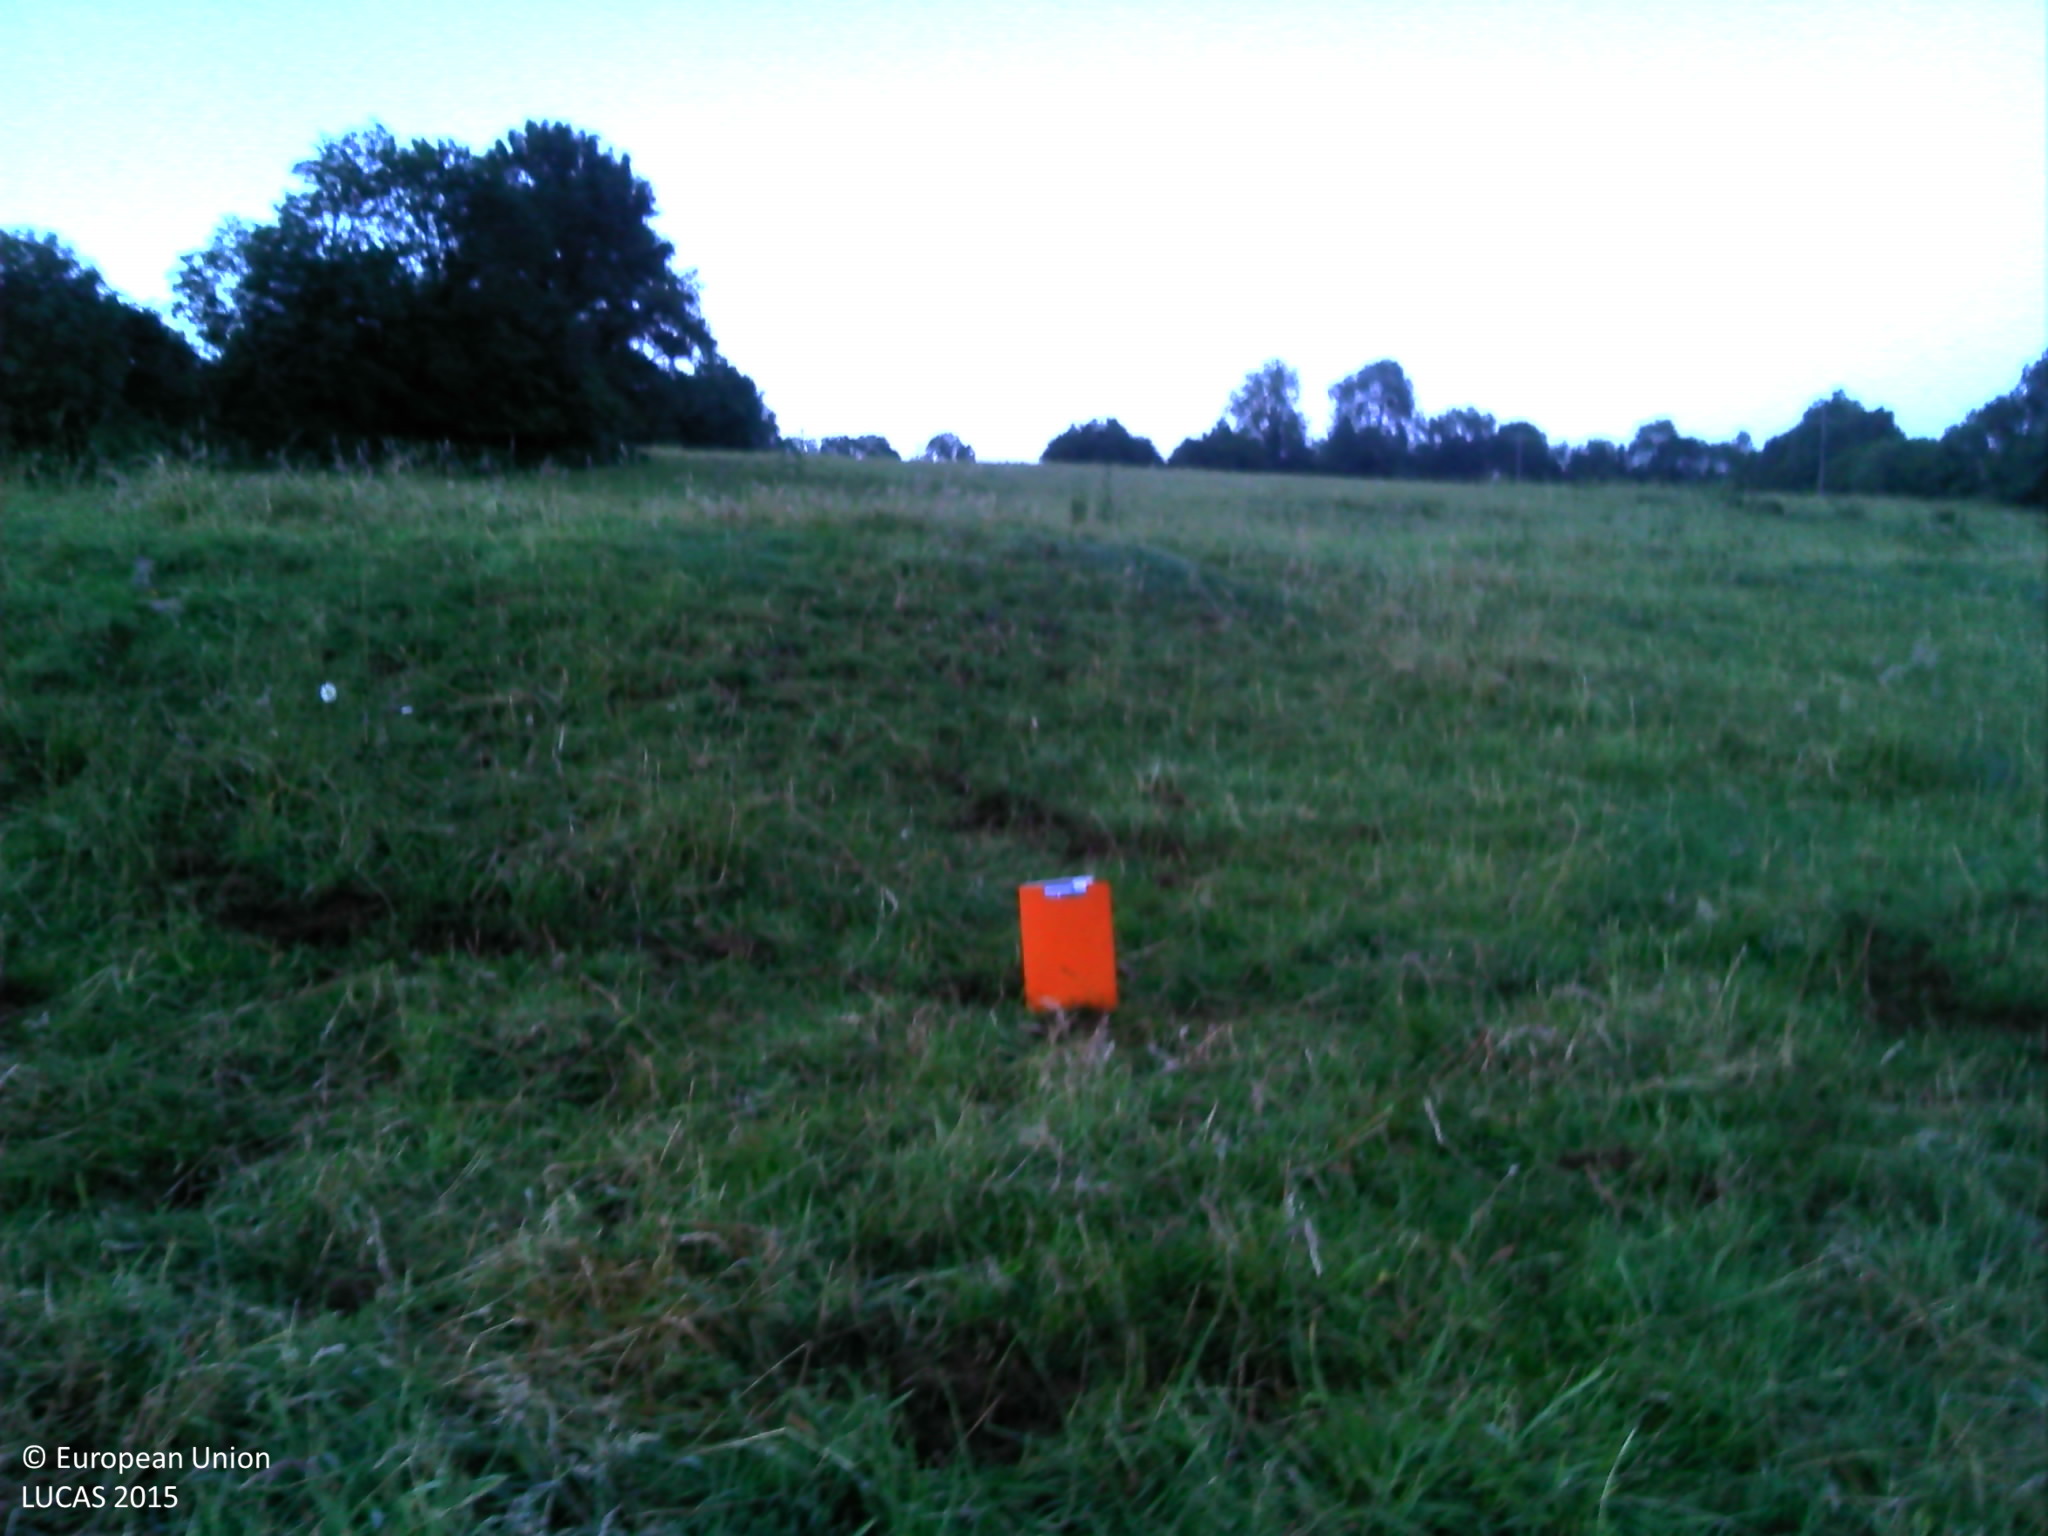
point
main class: Grassland
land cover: Grassland without tree/shrub cover
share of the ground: > 75 %
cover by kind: herbaceous plants 100 %
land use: Agriculture (excluding fallow land and kitchen gardens)
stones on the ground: > 50 %
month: June
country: FR
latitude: 45.2354
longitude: 2.4712
